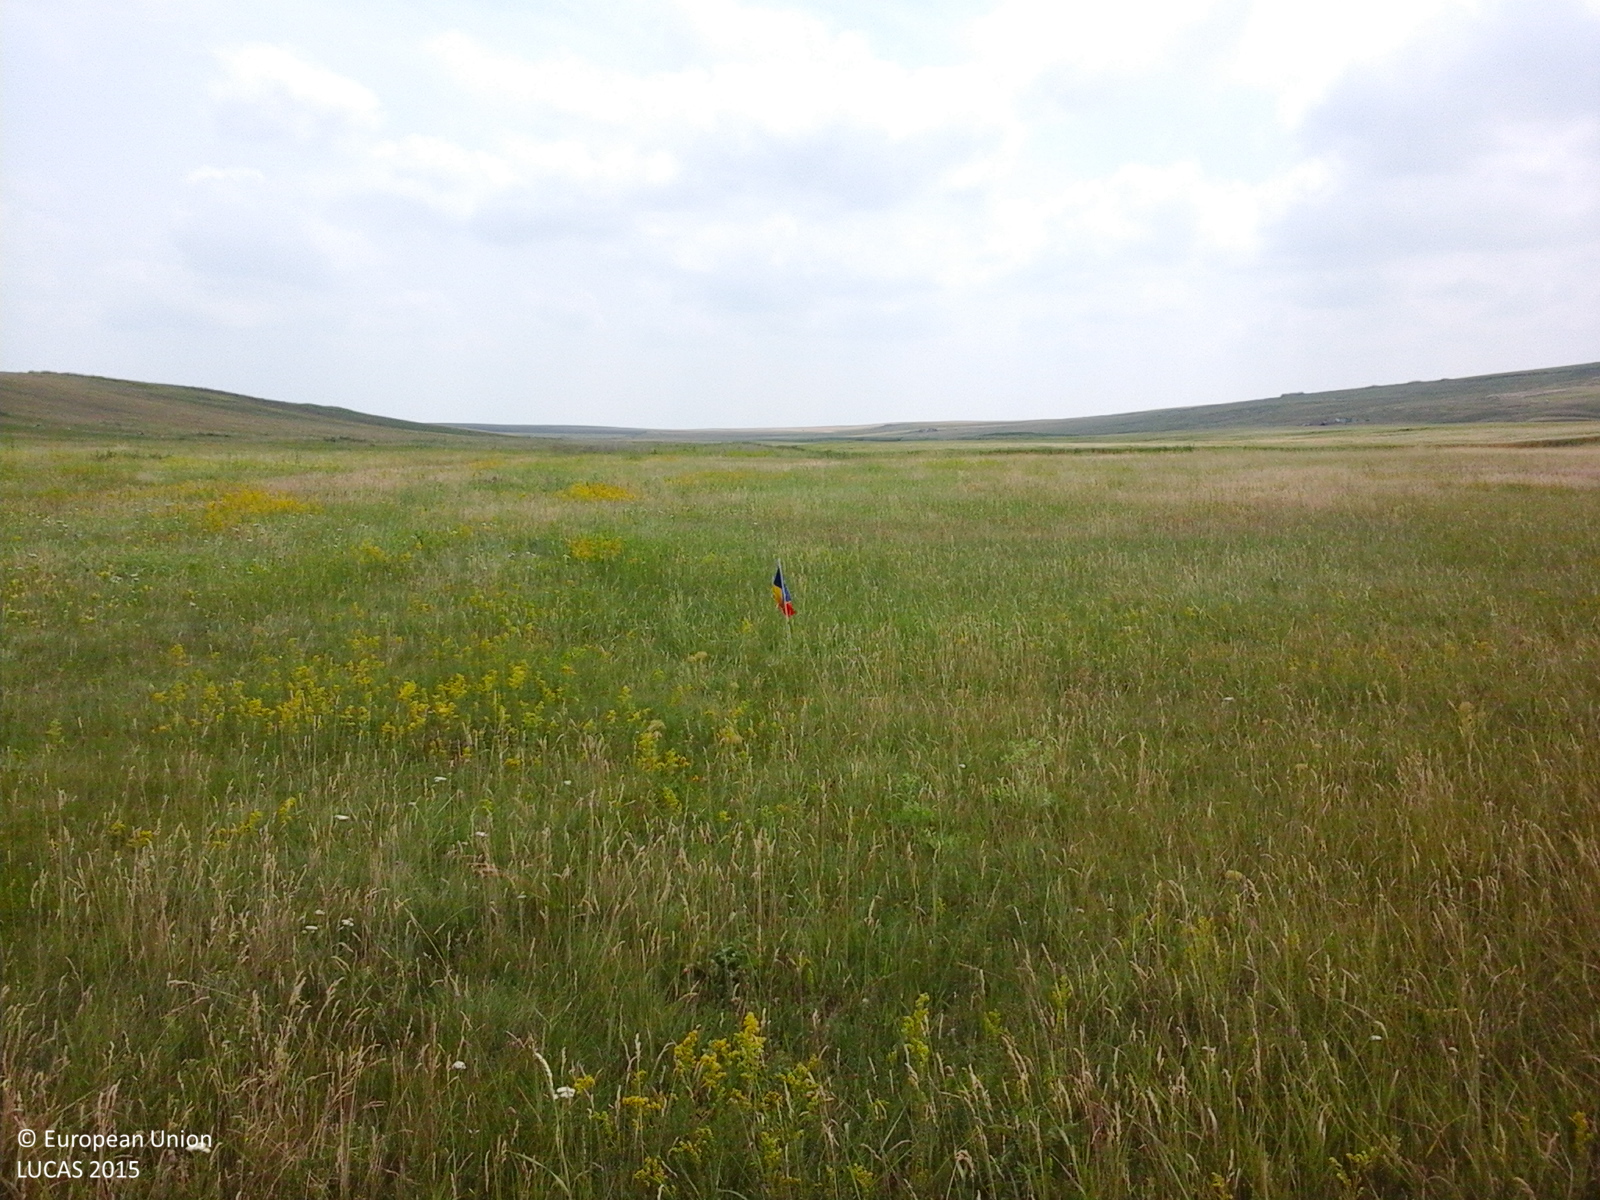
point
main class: Grassland
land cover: Grassland without tree/shrub cover
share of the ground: > 75 %
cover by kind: herbaceous plants 100 %
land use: Agriculture (excluding fallow land and kitchen gardens)
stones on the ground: < 10 %
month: June
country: RO
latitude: 48.0362
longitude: 26.6053
